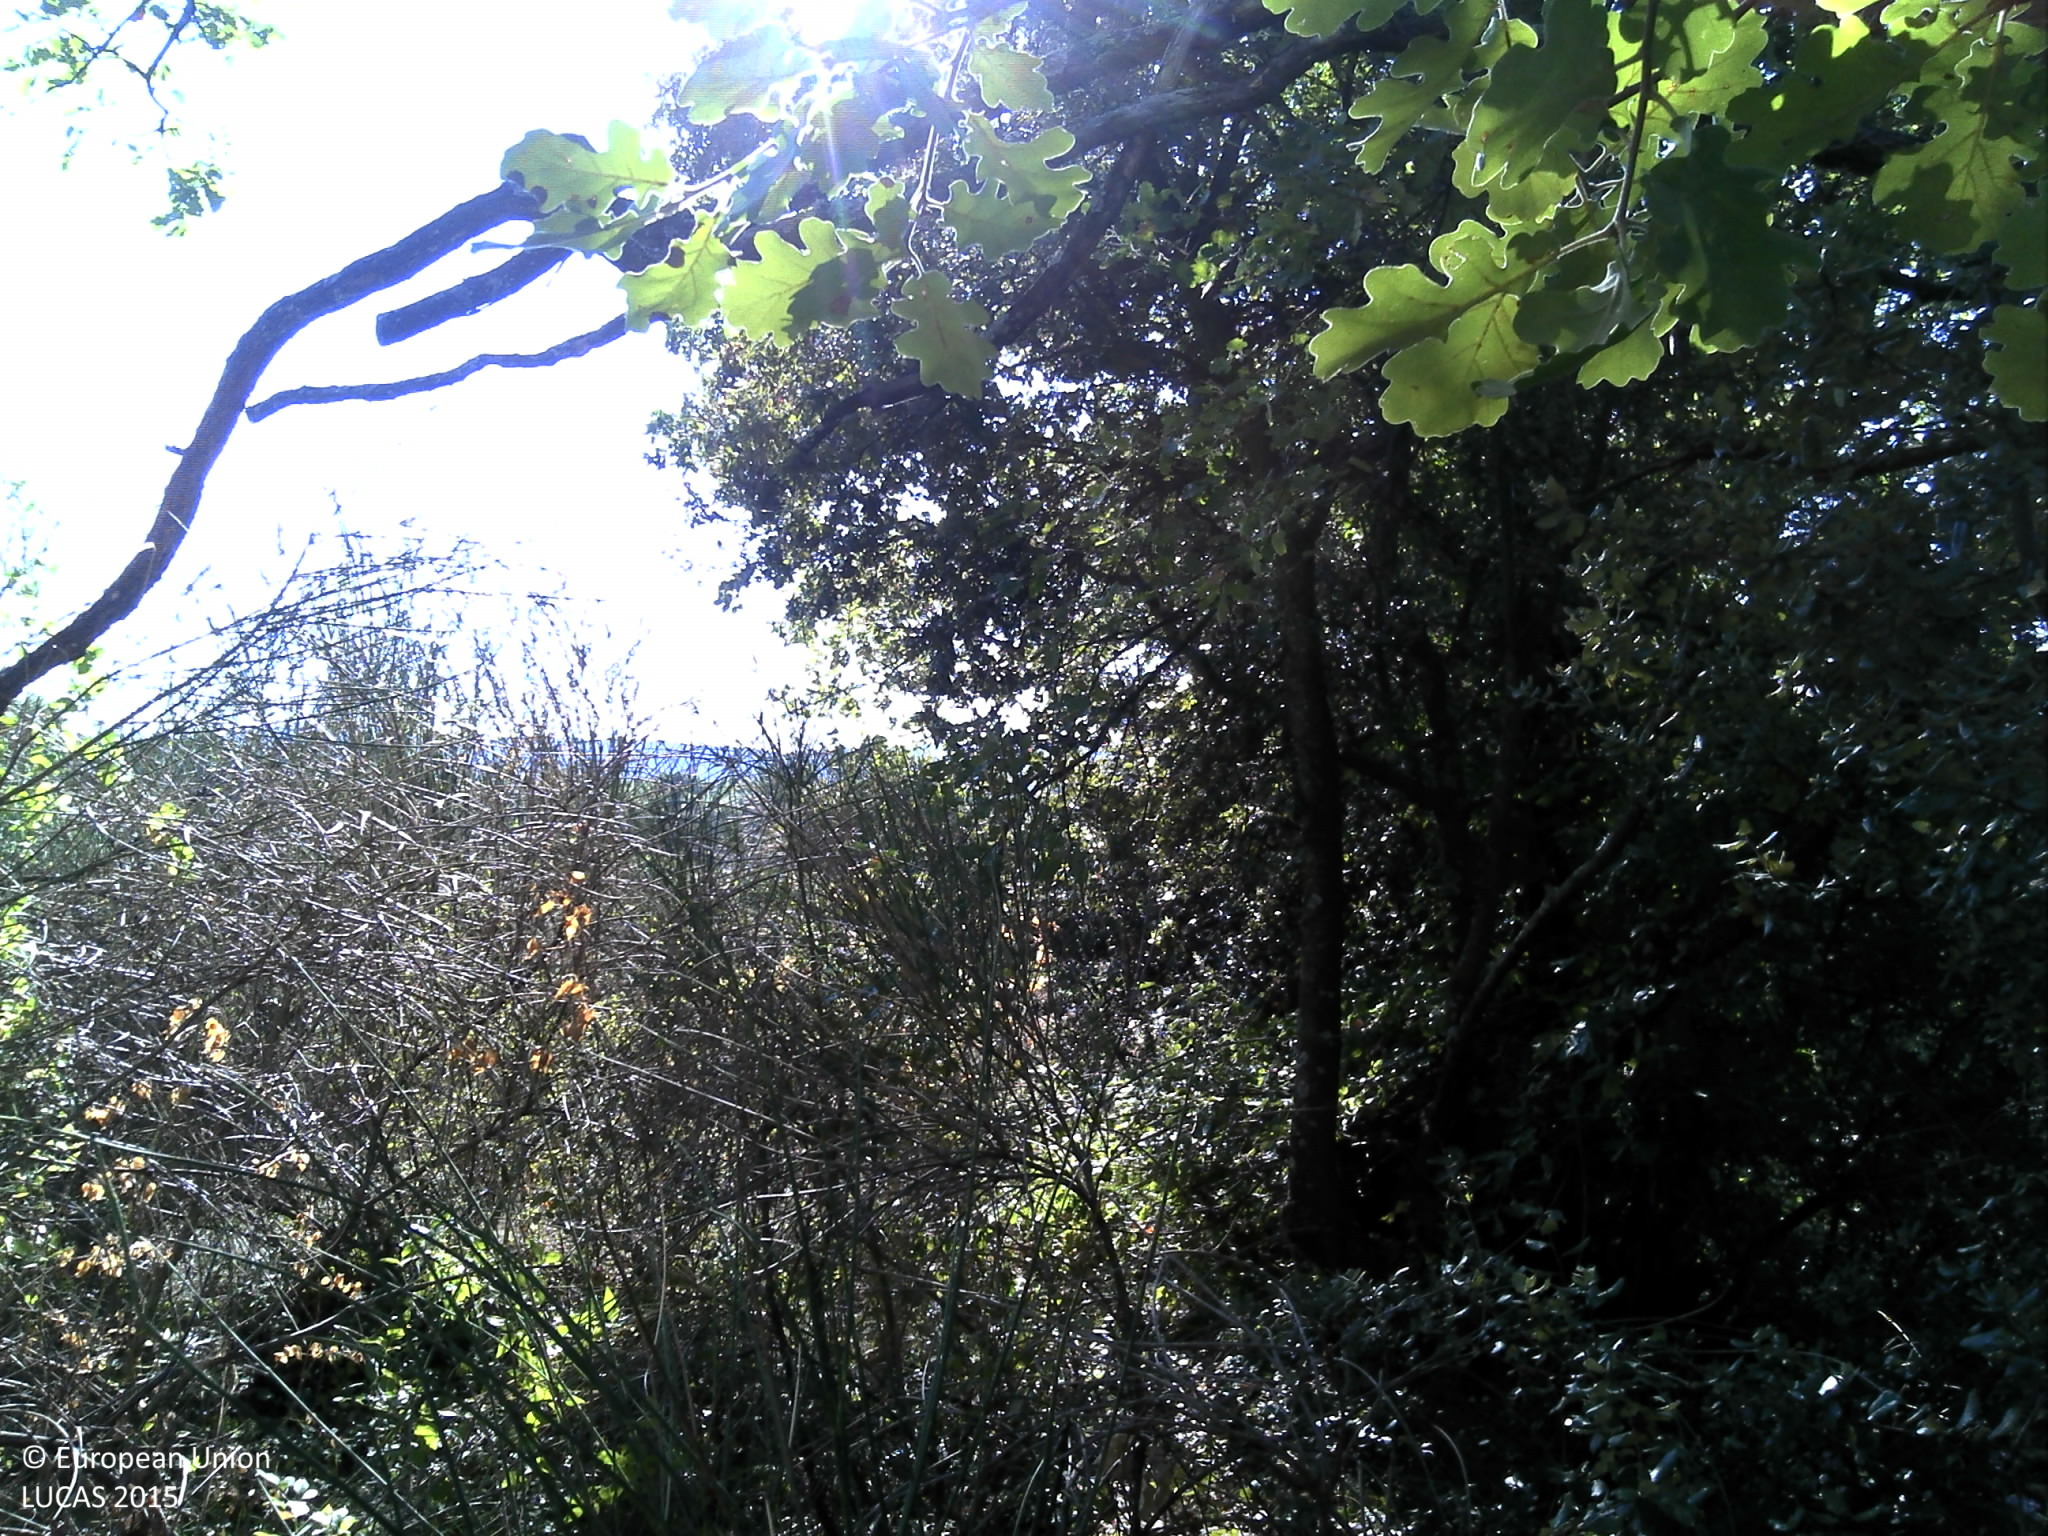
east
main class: Woodland
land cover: Broadleaved woodland
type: thermophilous deciduous forest
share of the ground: 50 - 75 %
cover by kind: broadleaved forest trees 70 %, shrubs 20 %, coniferous forest trees 10 %
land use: Forestry
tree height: > 5 m
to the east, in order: Broadleaved woodland; Shrubland with sparse tree cover; Grassland without tree/shrub cover; Tracks; Grass margins; Fences; Grassland without tree/shrub cover; Tracks; Pine dominated mixed woodland
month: September
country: FR
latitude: 43.7864
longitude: 5.5726
